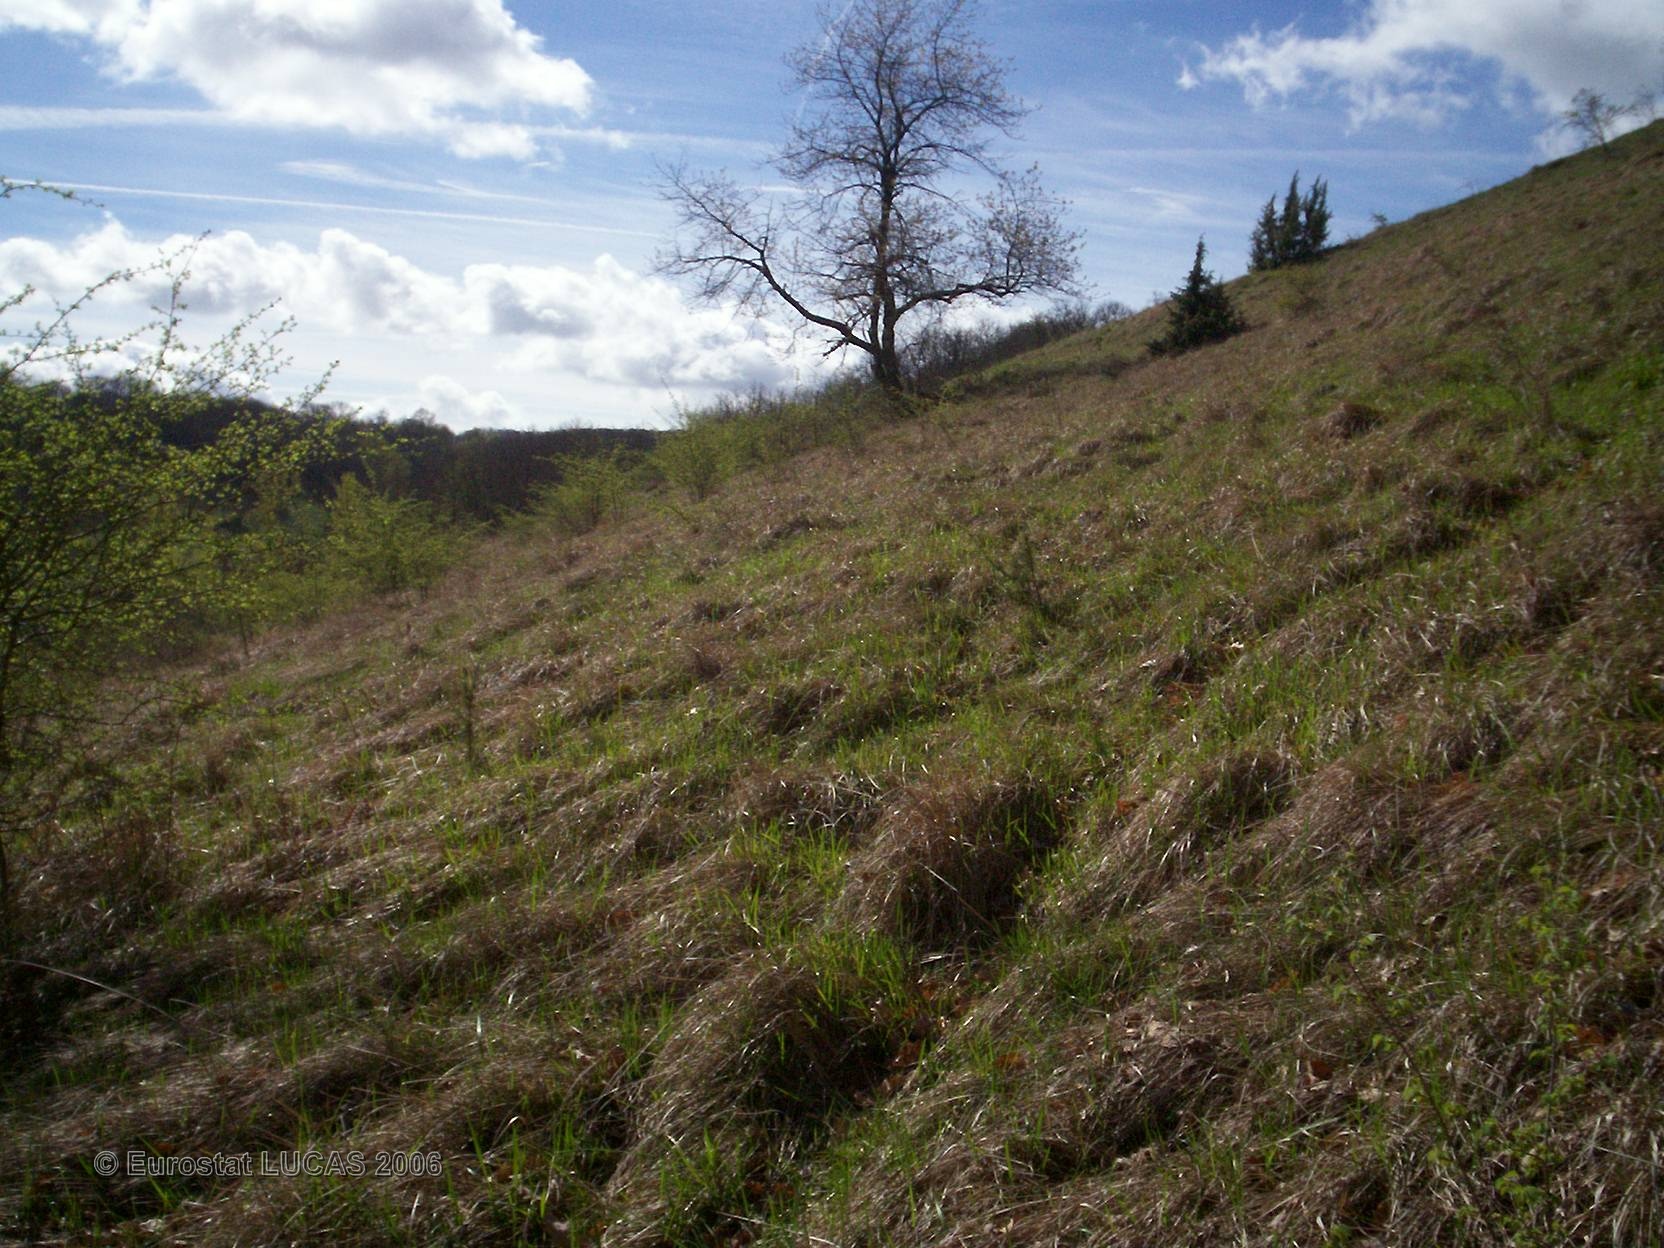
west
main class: Woodland
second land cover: Grassland without tree/shrub cover
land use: Unused
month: April
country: FR
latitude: 44.1860
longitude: 0.9017
